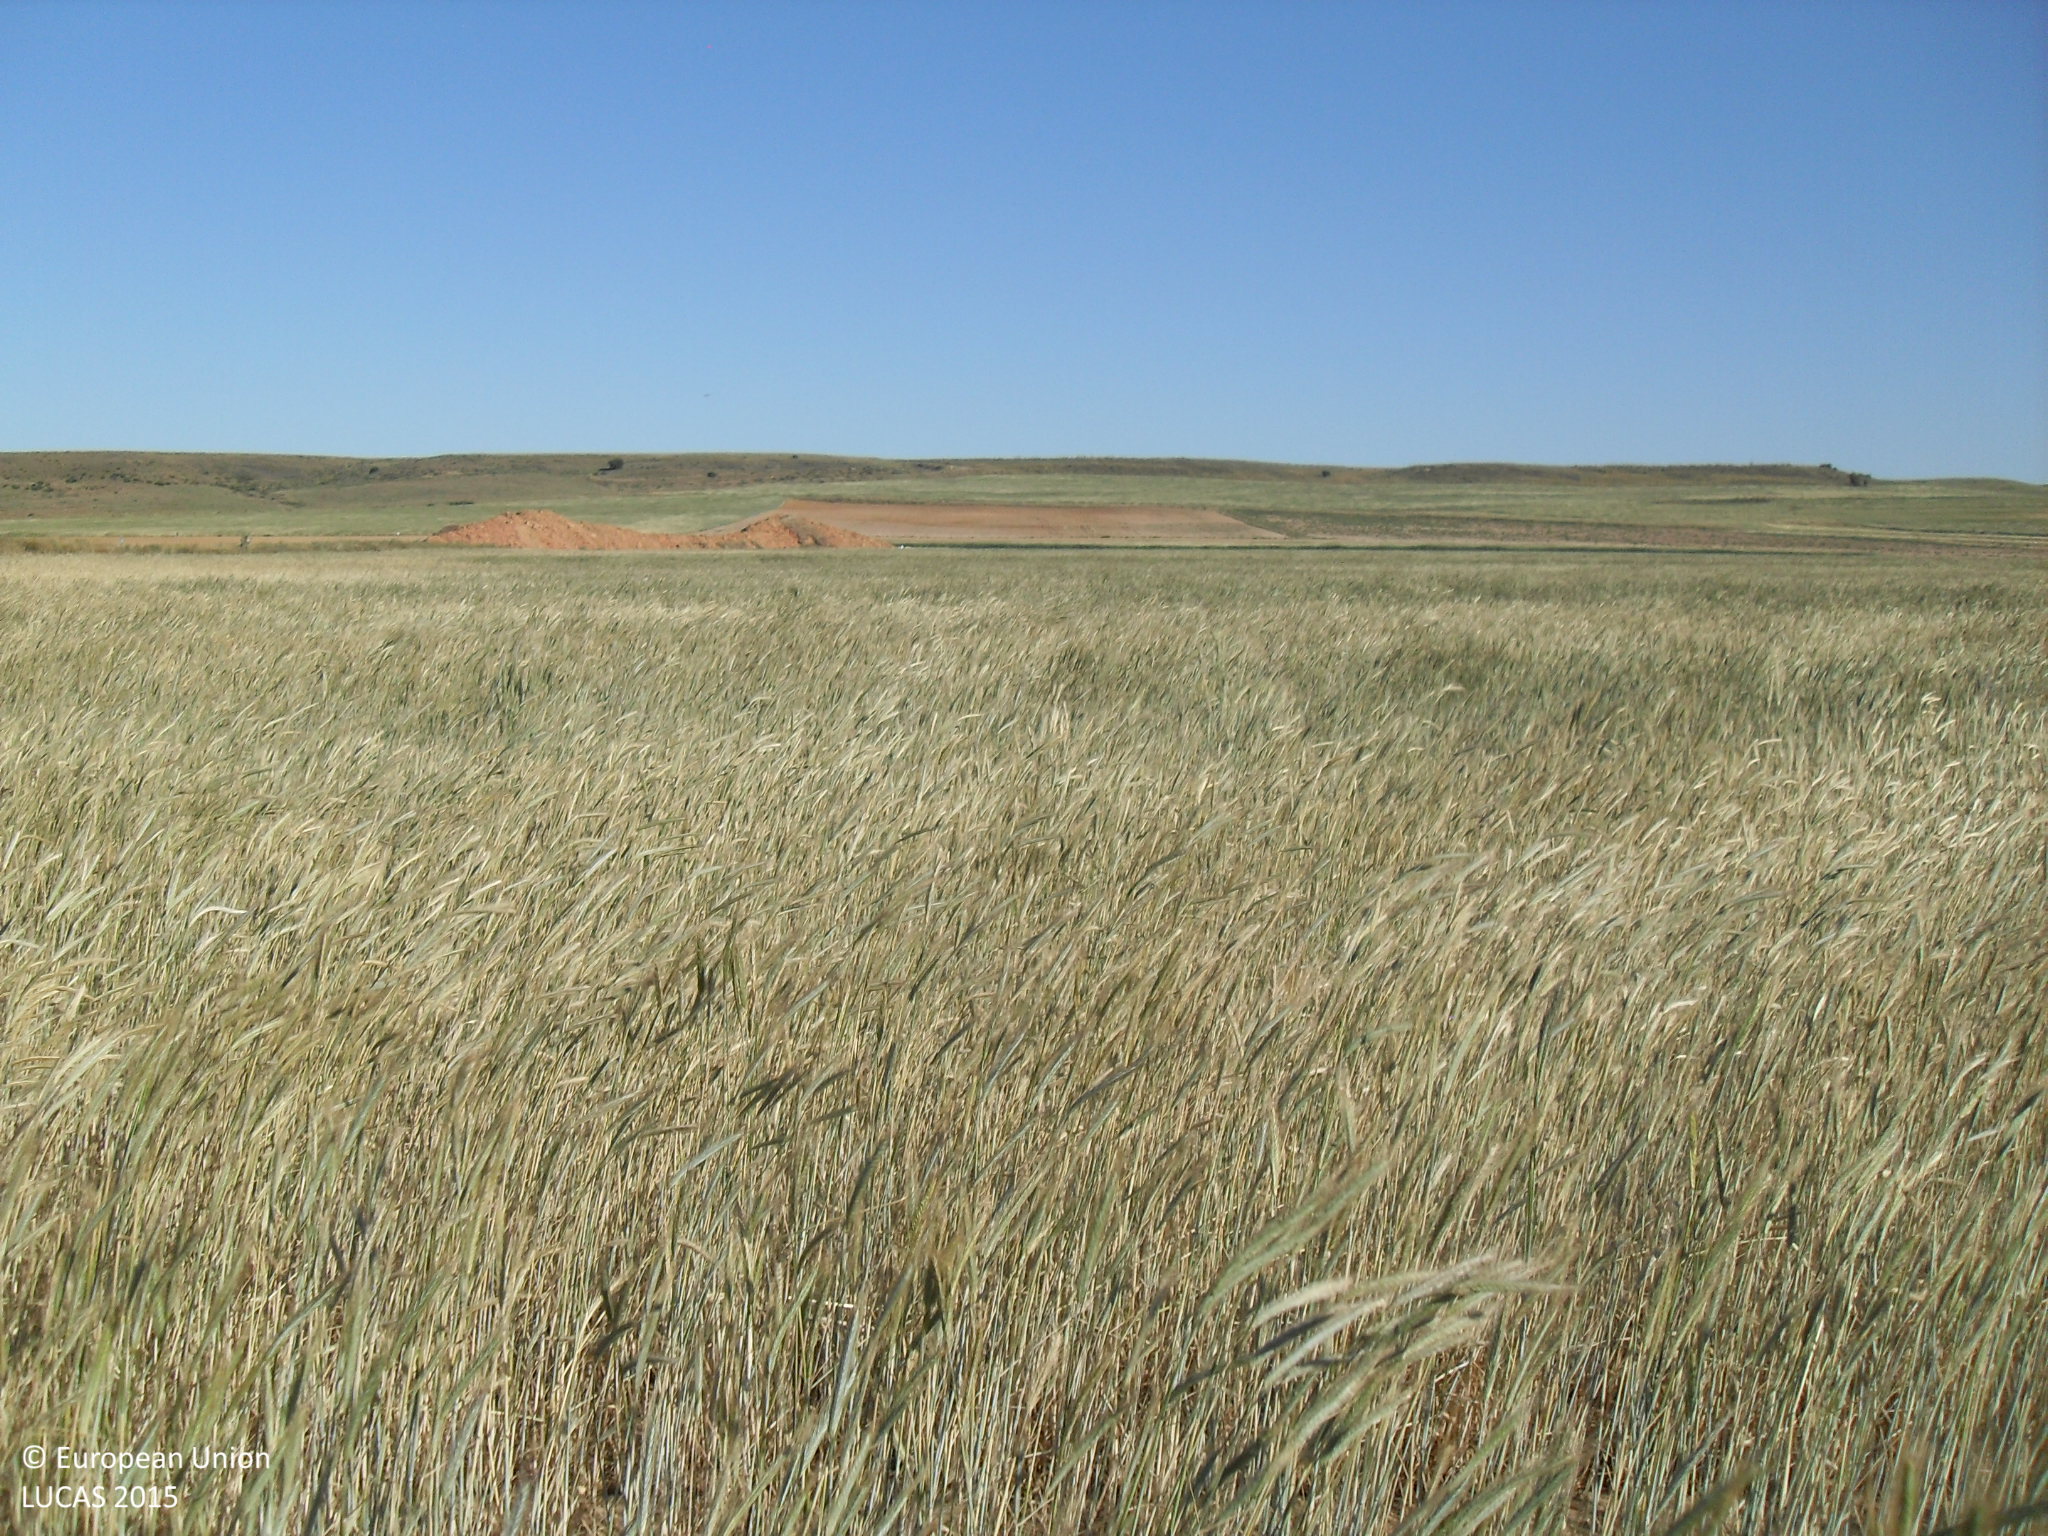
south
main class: Cropland
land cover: Rye
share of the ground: > 75 %
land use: Agriculture (excluding fallow land and kitchen gardens)
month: May
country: ES
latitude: 41.0842
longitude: -5.2724
